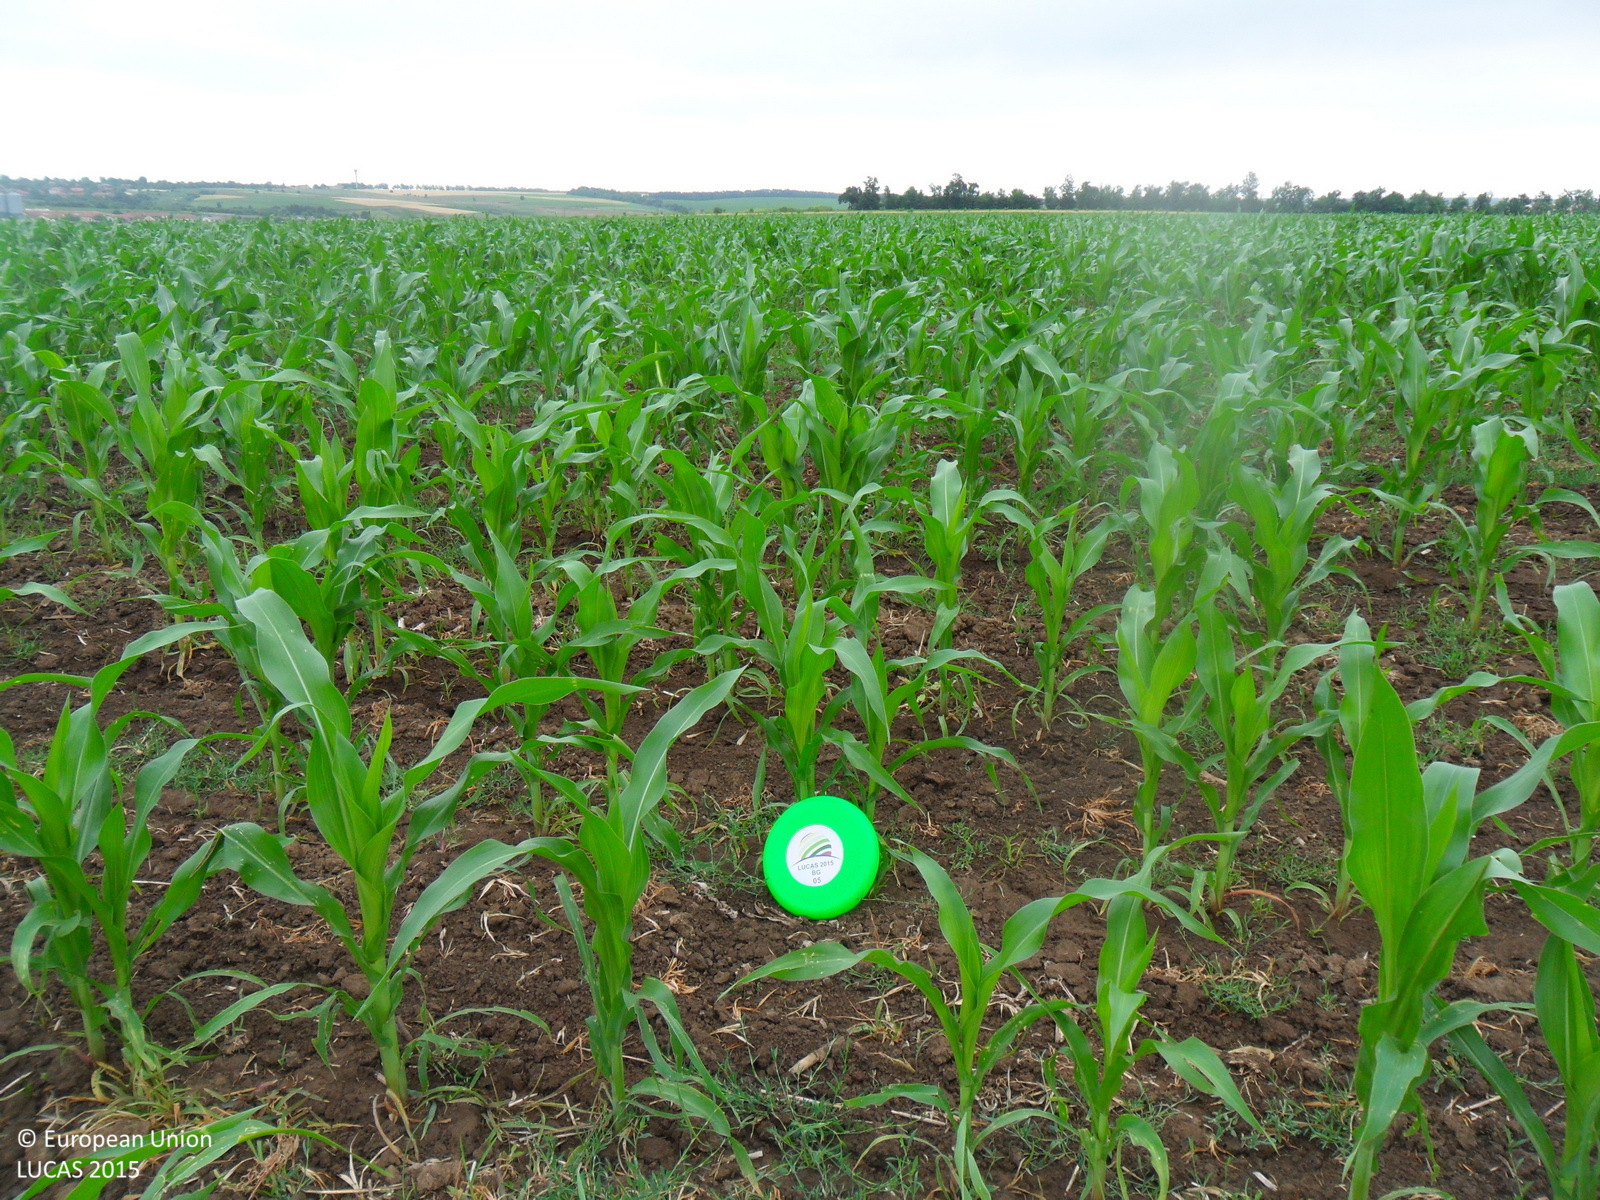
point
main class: Cropland
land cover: Maize
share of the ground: 25 - 50 %
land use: Agriculture (excluding fallow land and kitchen gardens)
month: June
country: BG
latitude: 43.7453
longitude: 26.6646
